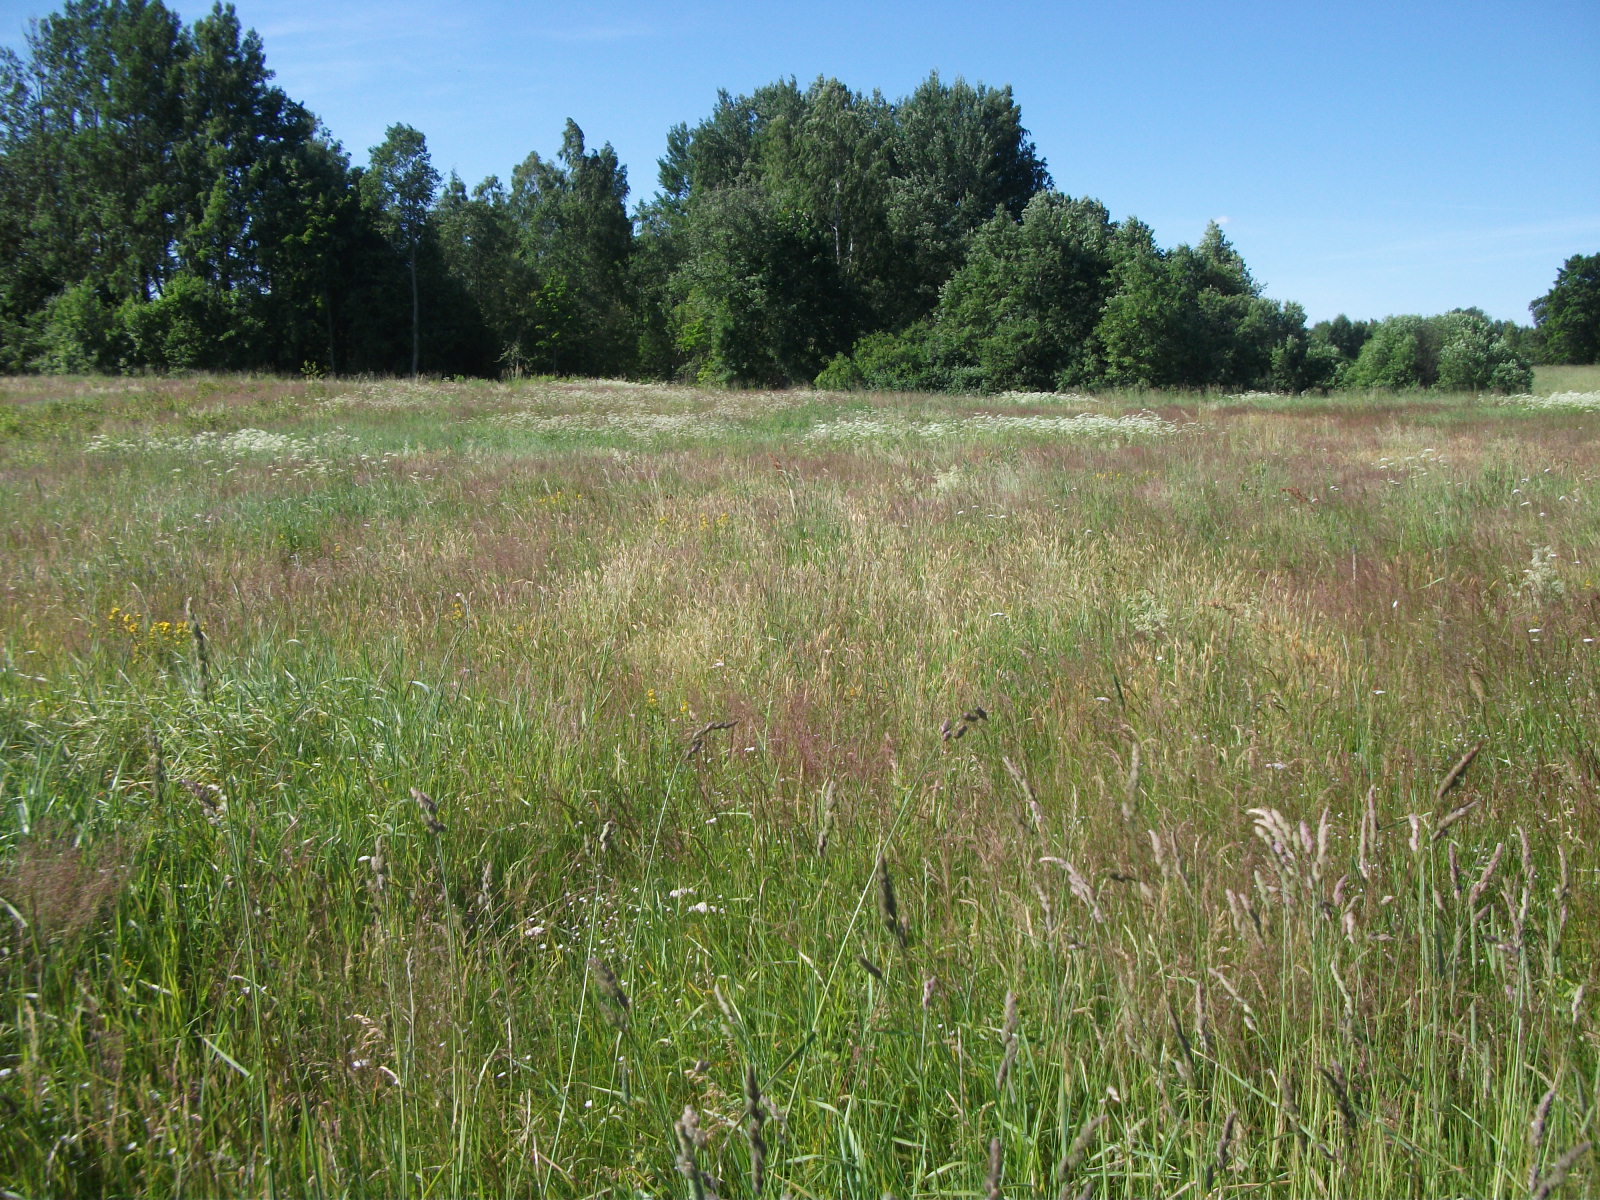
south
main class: Grassland
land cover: Grassland without tree/shrub cover
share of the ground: > 75 %
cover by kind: herbaceous plants 100 %
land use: Agriculture (excluding fallow land and kitchen gardens)
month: July
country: LV
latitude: 56.7156
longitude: 26.1649
